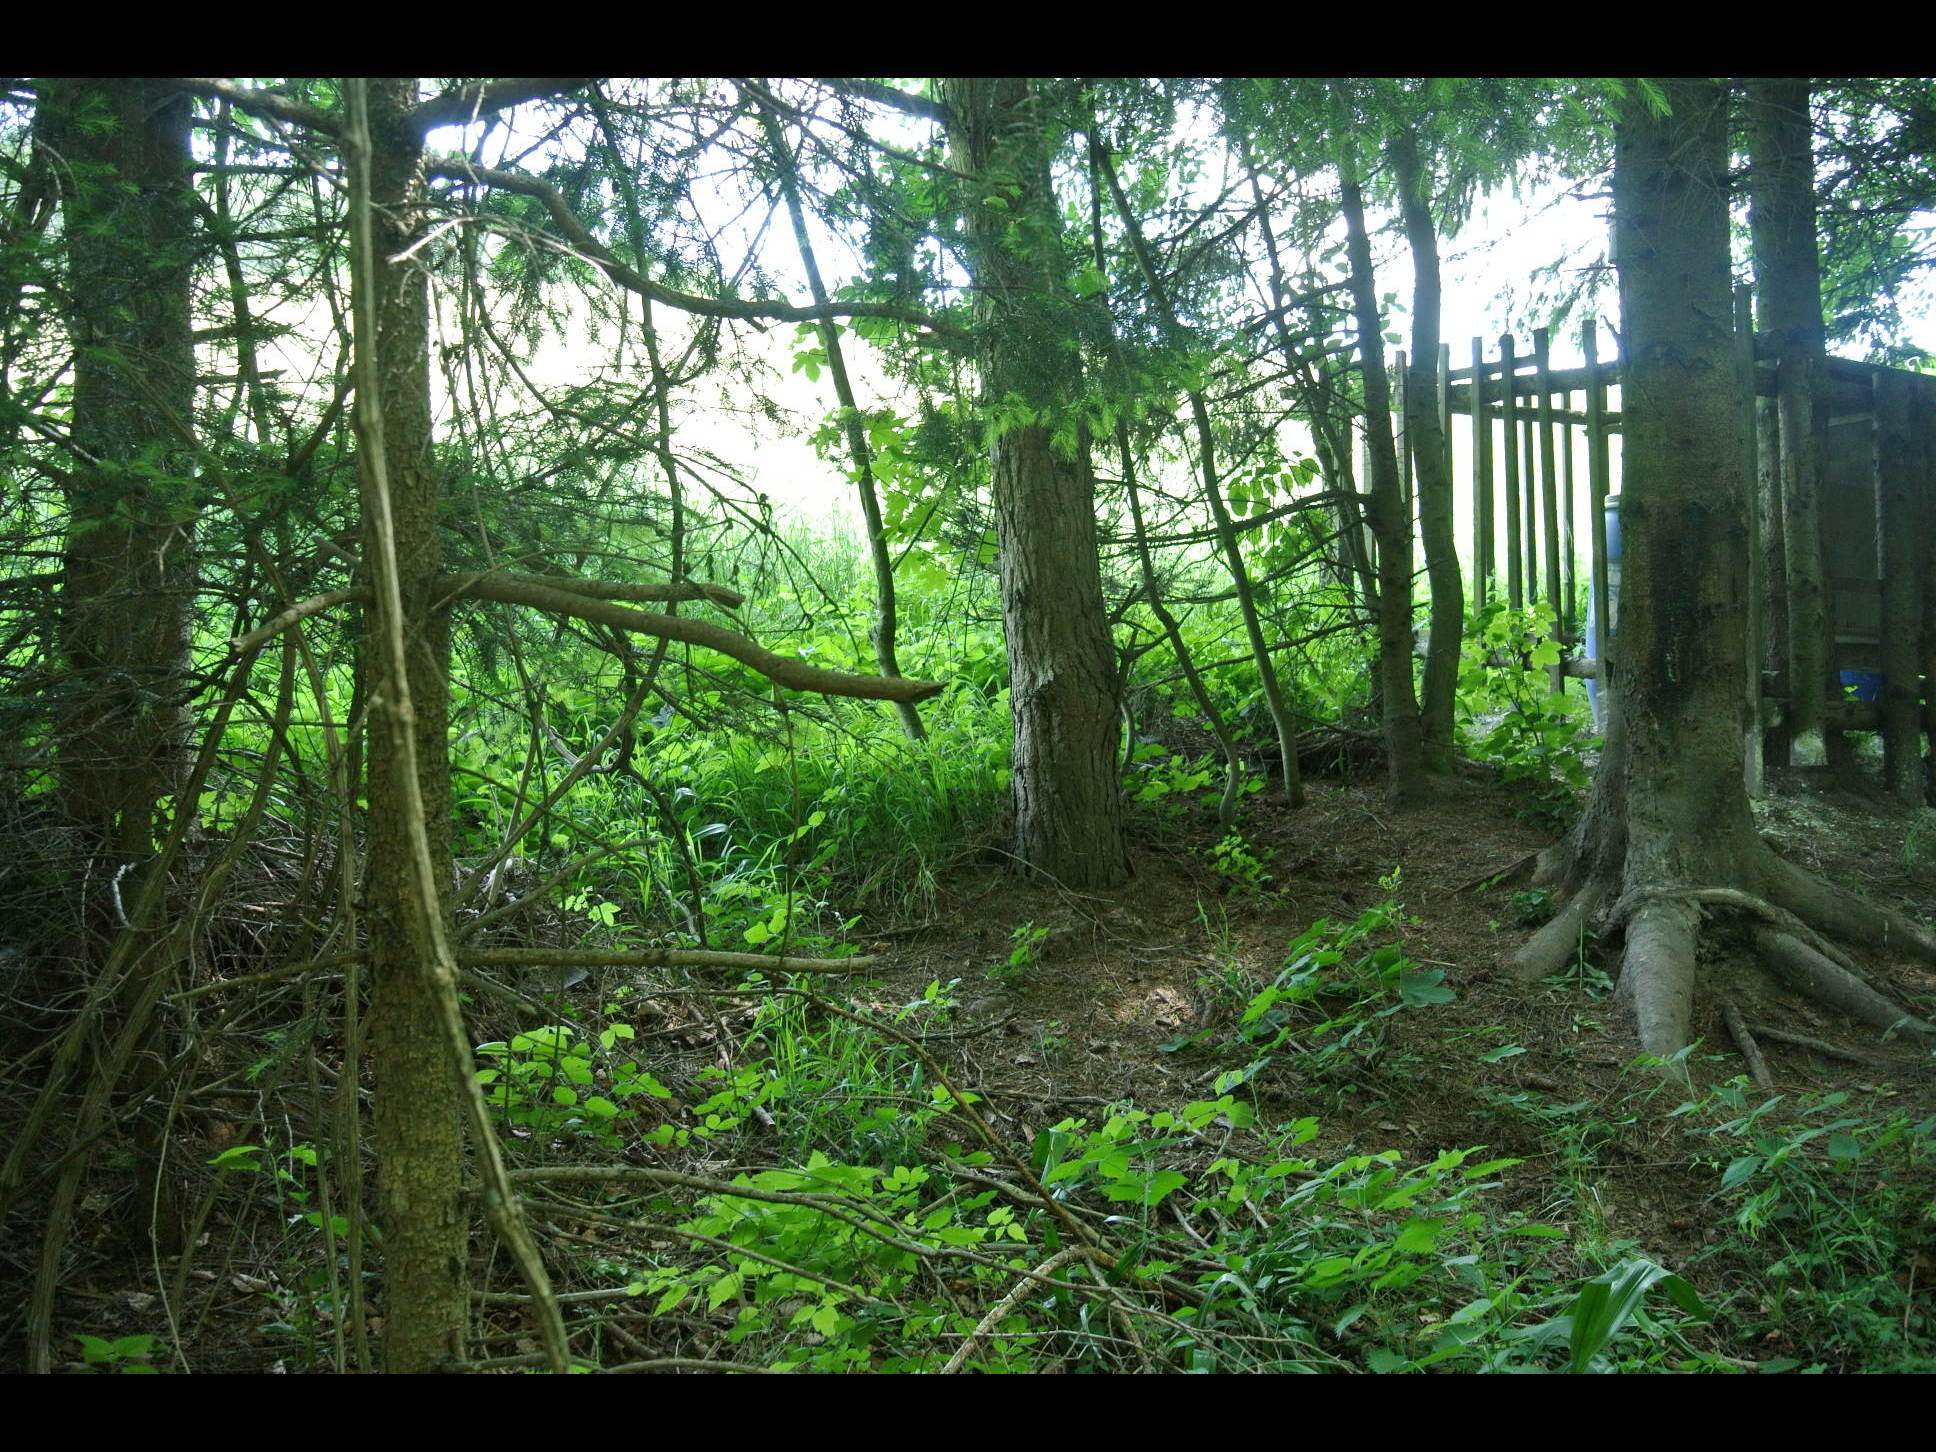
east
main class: Woodland
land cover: Spruce dominated mixed woodland
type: alpine coniferous forest
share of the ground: > 75 %
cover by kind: broadleaved forest trees 75 %, coniferous forest trees 25 %
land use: Forestry
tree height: > 5 m
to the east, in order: Spruce dominated mixed woodland; Grassland without tree/shrub cover; Fences; Pine dominated mixed woodland; Tracks; Pine dominated mixed woodland
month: June
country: AT
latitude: 48.0198
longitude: 16.0773
